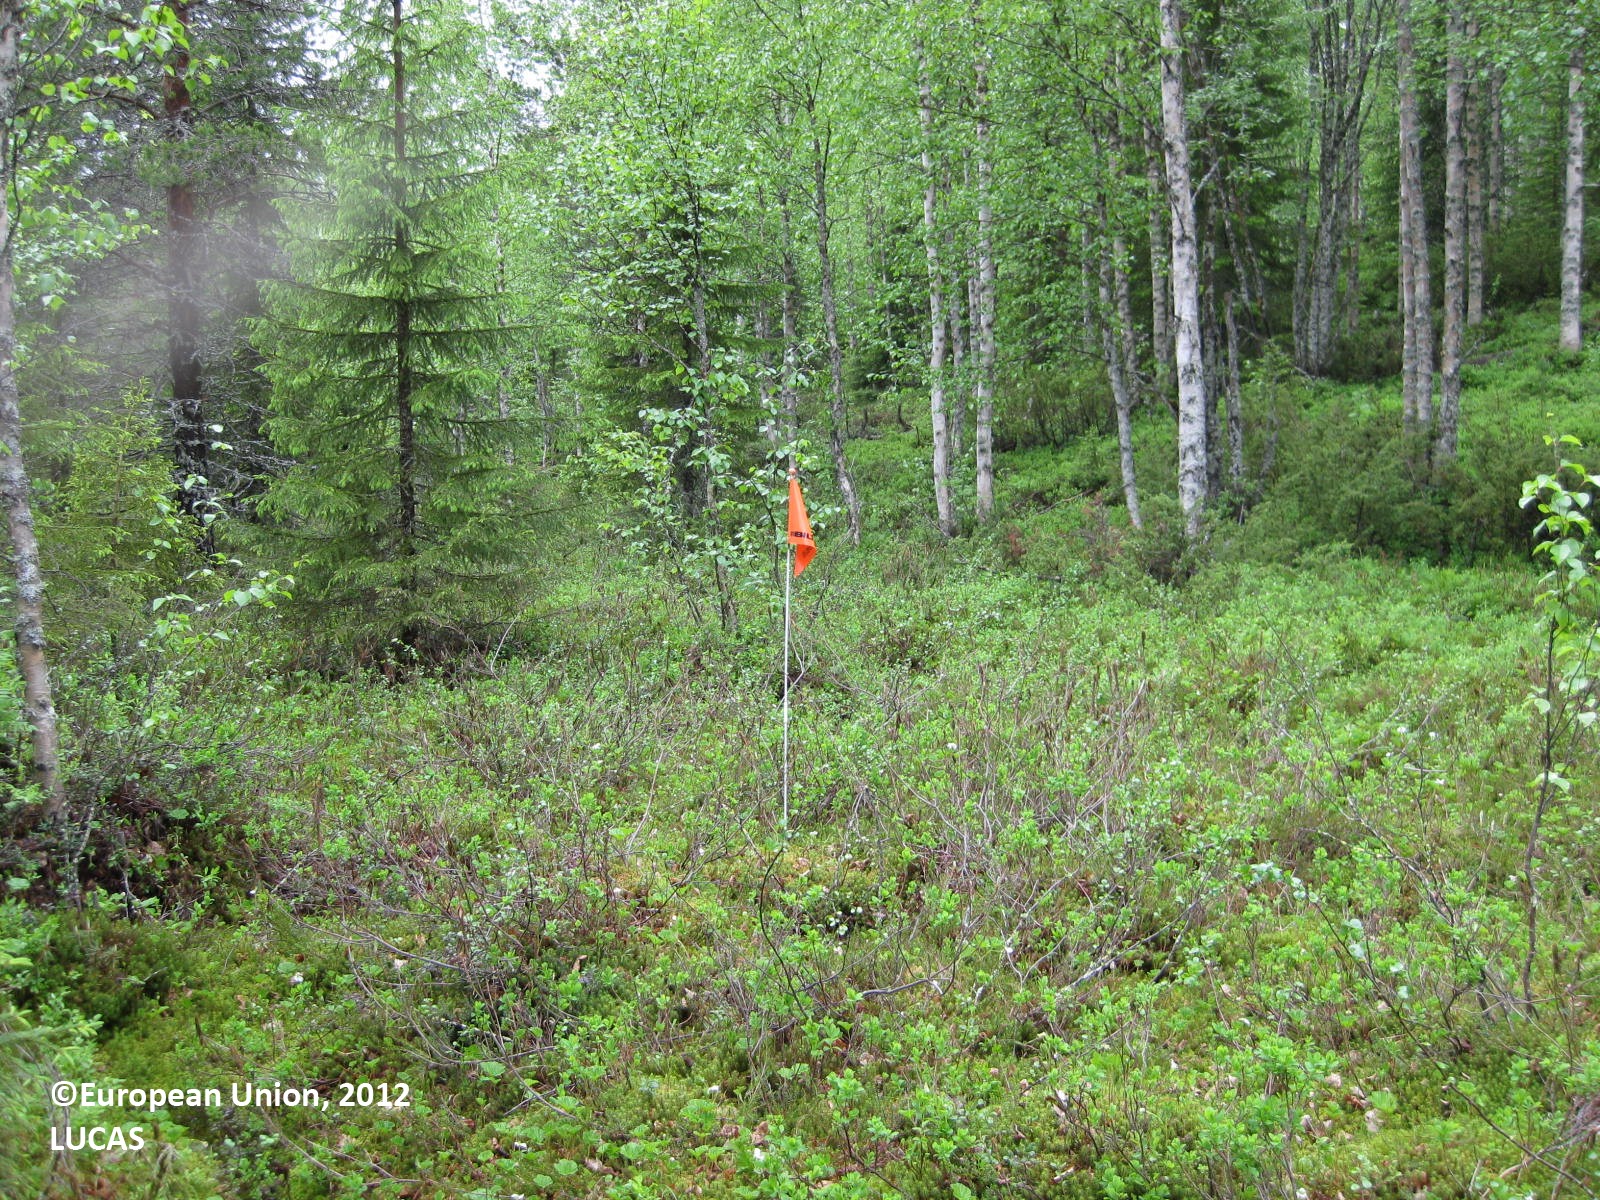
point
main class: Woodland
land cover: Other mixed woodland
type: boreal forest
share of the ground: 50 - 75 %
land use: Forestry
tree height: > 5 m
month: June
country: FI
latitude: 65.1107
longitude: 28.9439
